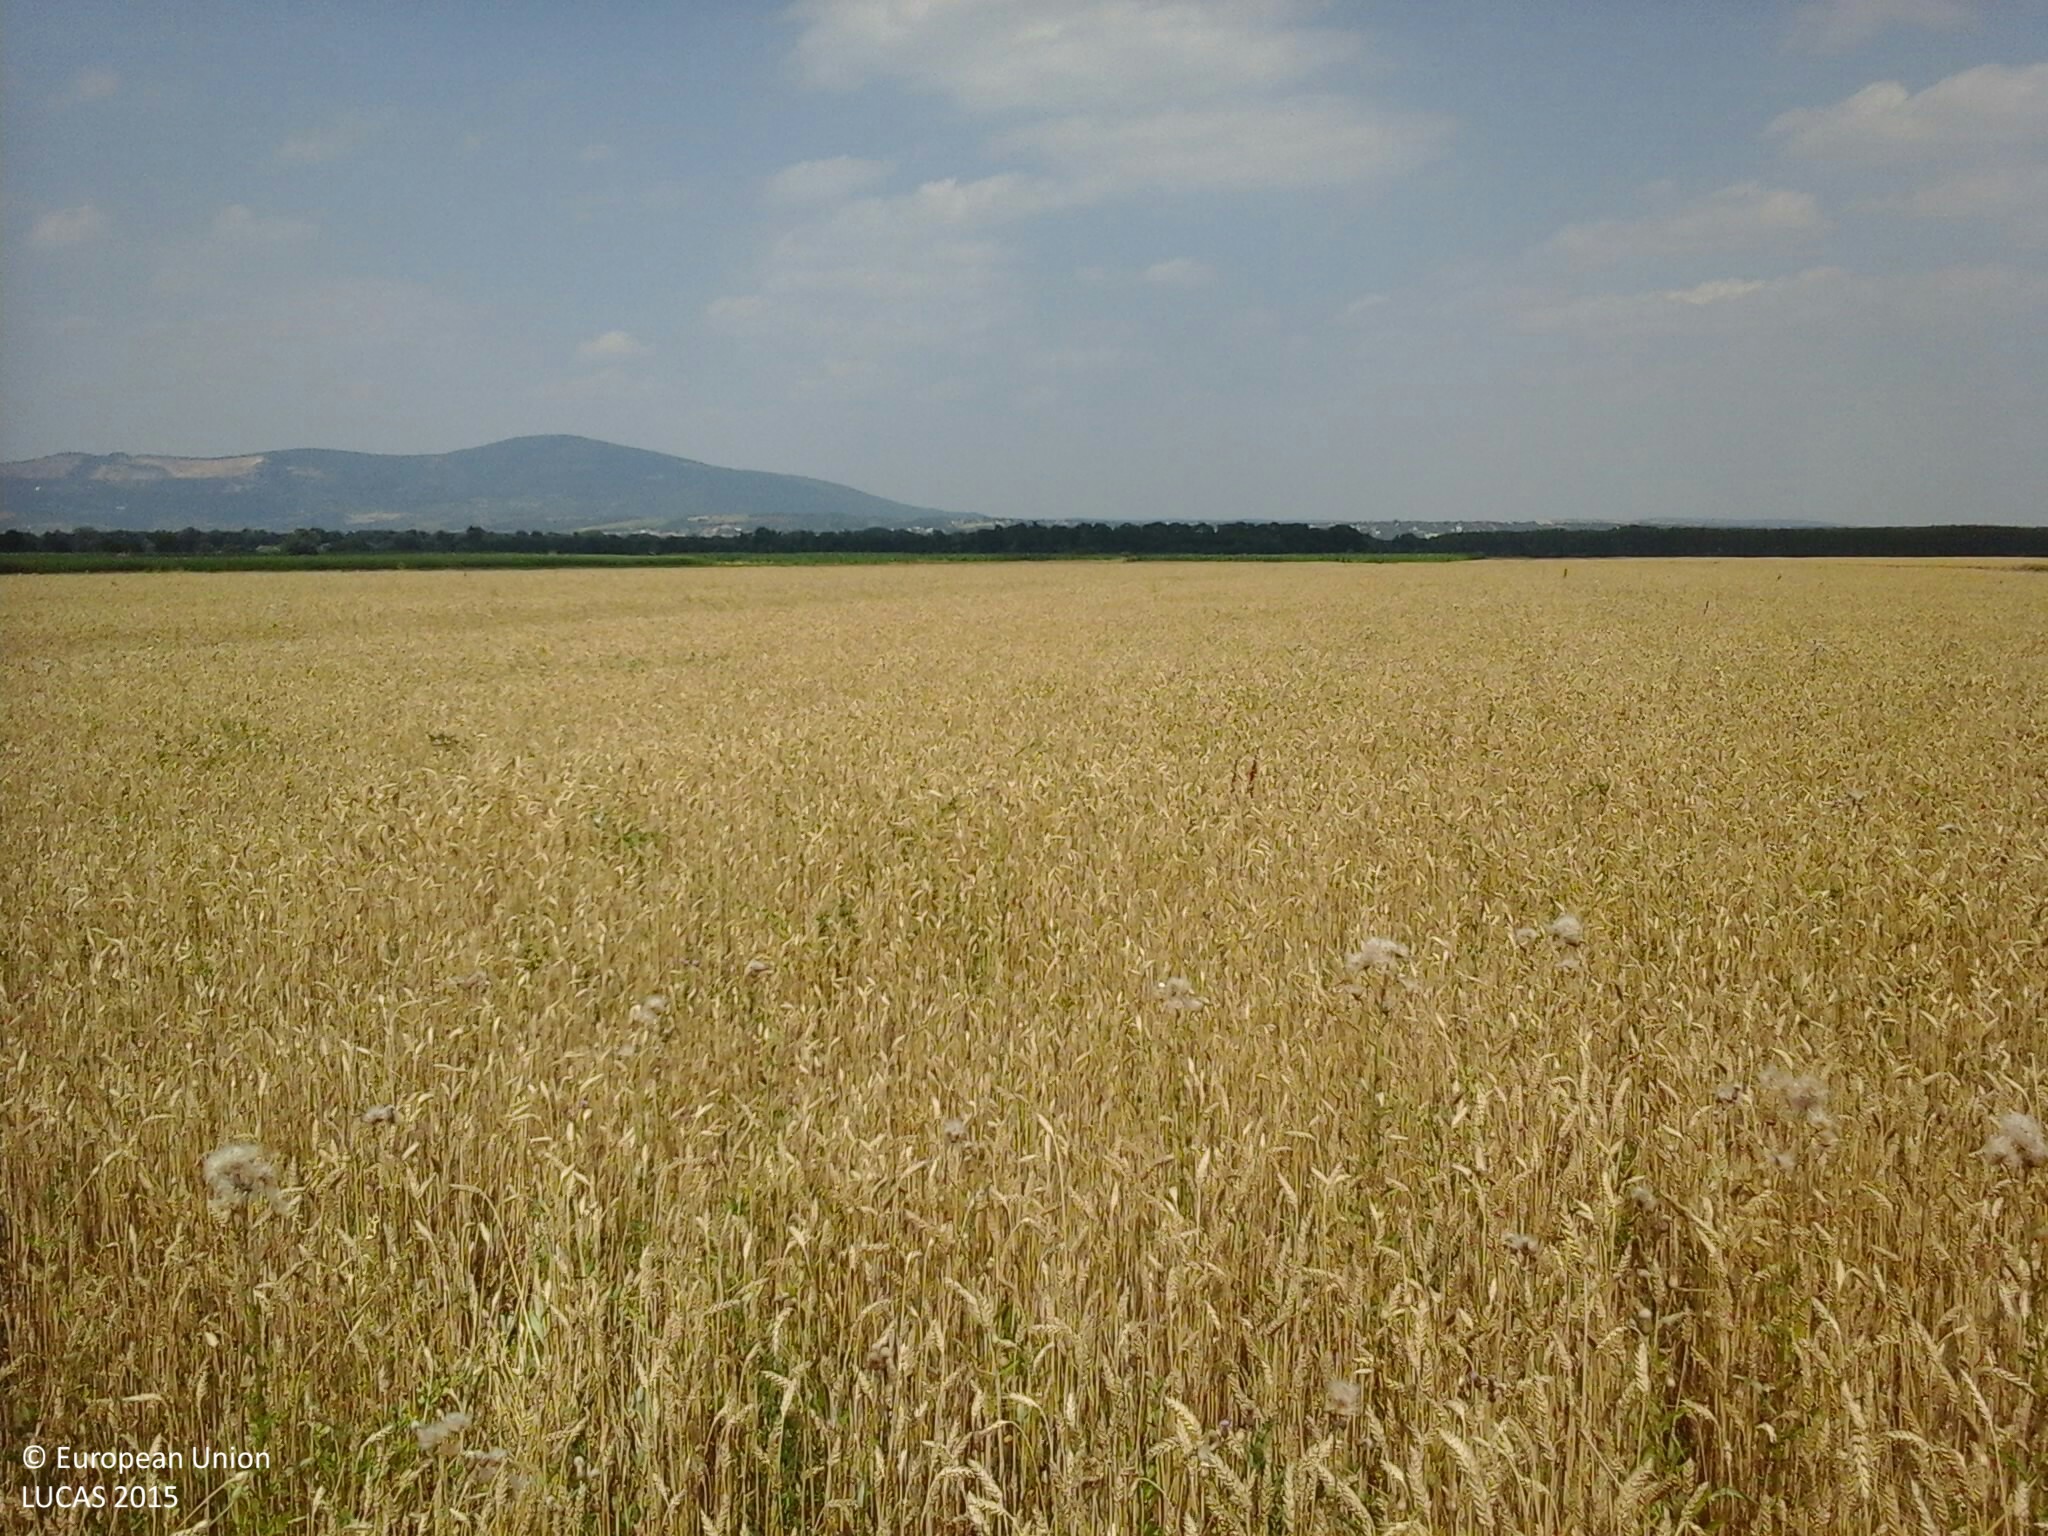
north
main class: Cropland
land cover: Common wheat
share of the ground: > 75 %
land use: Agriculture (excluding fallow land and kitchen gardens)
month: July
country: HU
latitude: 47.7557
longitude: 19.1036
